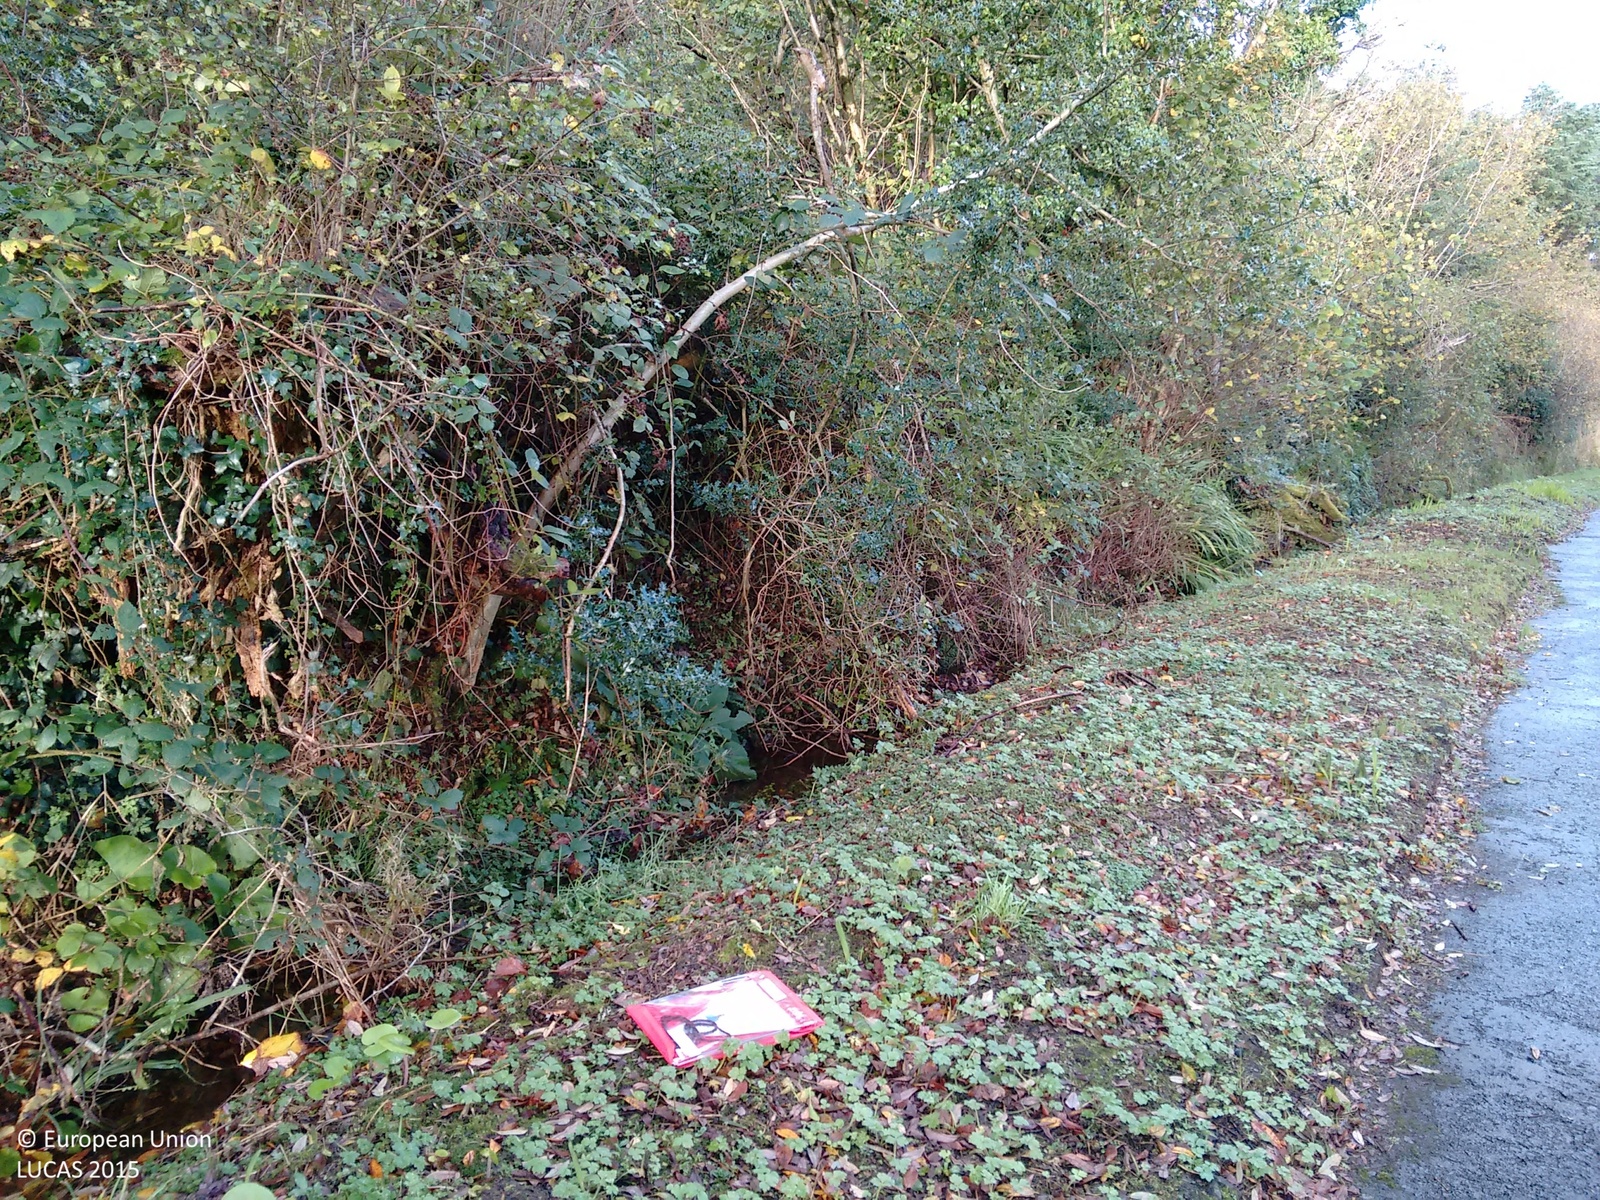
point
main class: Woodland
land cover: Broadleaved woodland
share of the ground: > 75 %
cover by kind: broadleaved forest trees 80 %, herbaceous plants 20 %
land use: Semi-natural and natural areas not in use
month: November
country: IE
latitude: 54.6493
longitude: -8.4292
